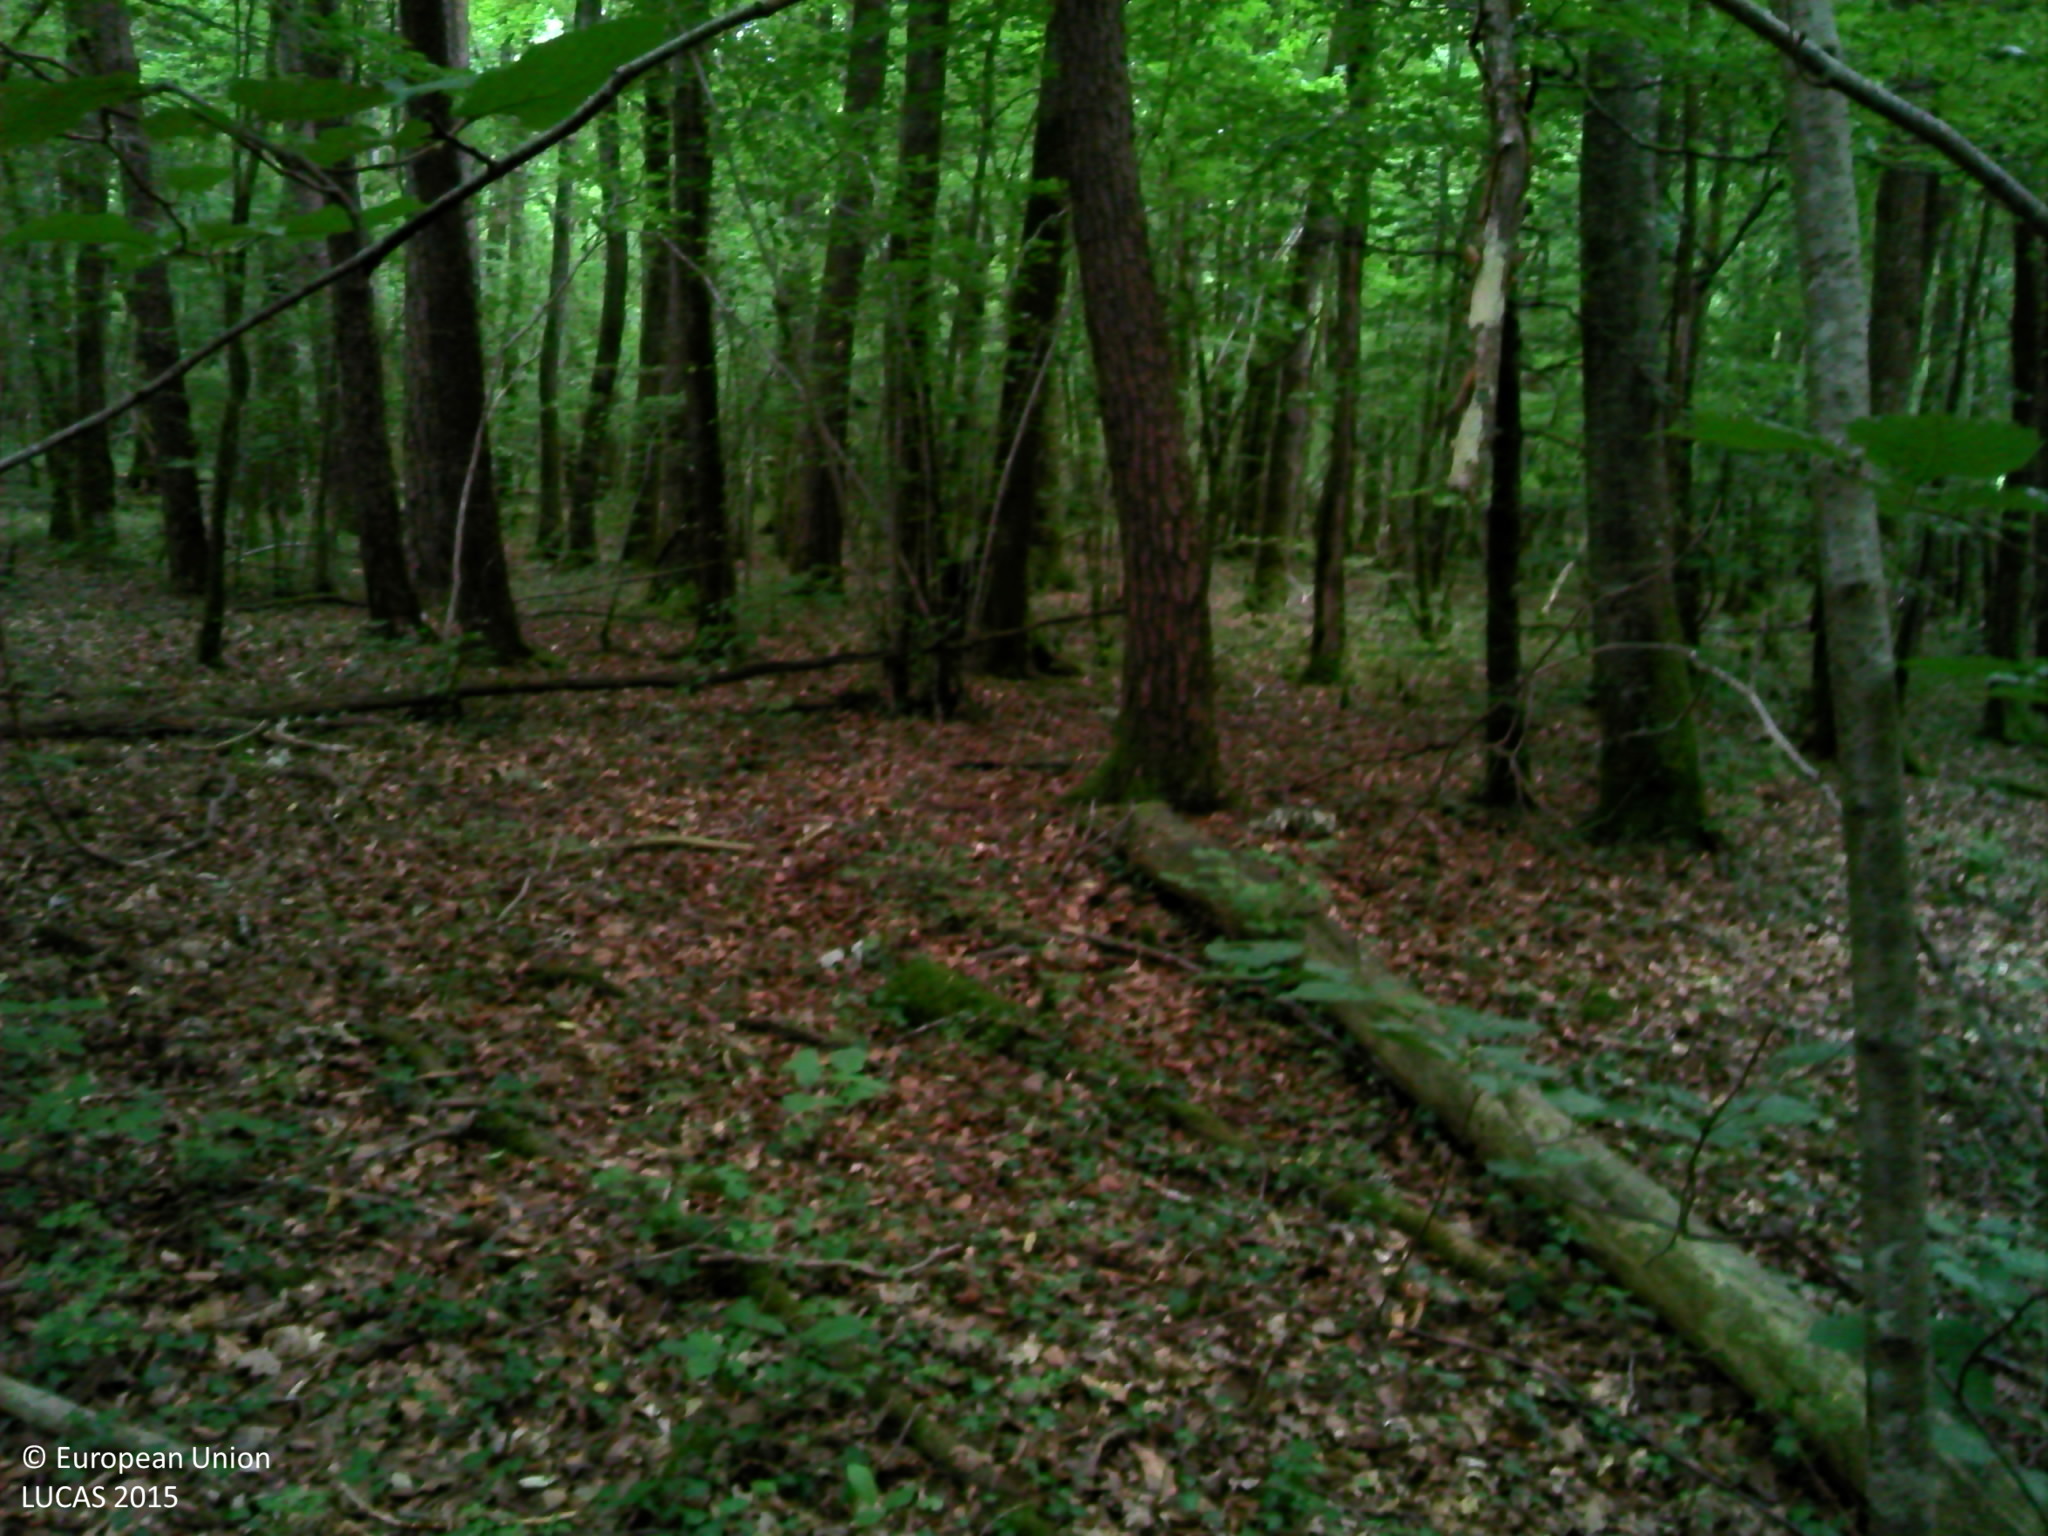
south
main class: Woodland
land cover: Broadleaved woodland
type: mesophytic deciduous forest
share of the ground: > 75 %
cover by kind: broadleaved forest trees 85 %, shrubs 5 %, herbaceous plants 5 %, lichens and mosses 5 %
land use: Forestry
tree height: > 5 m
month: August
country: FR
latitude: 47.8757
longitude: 4.2617
